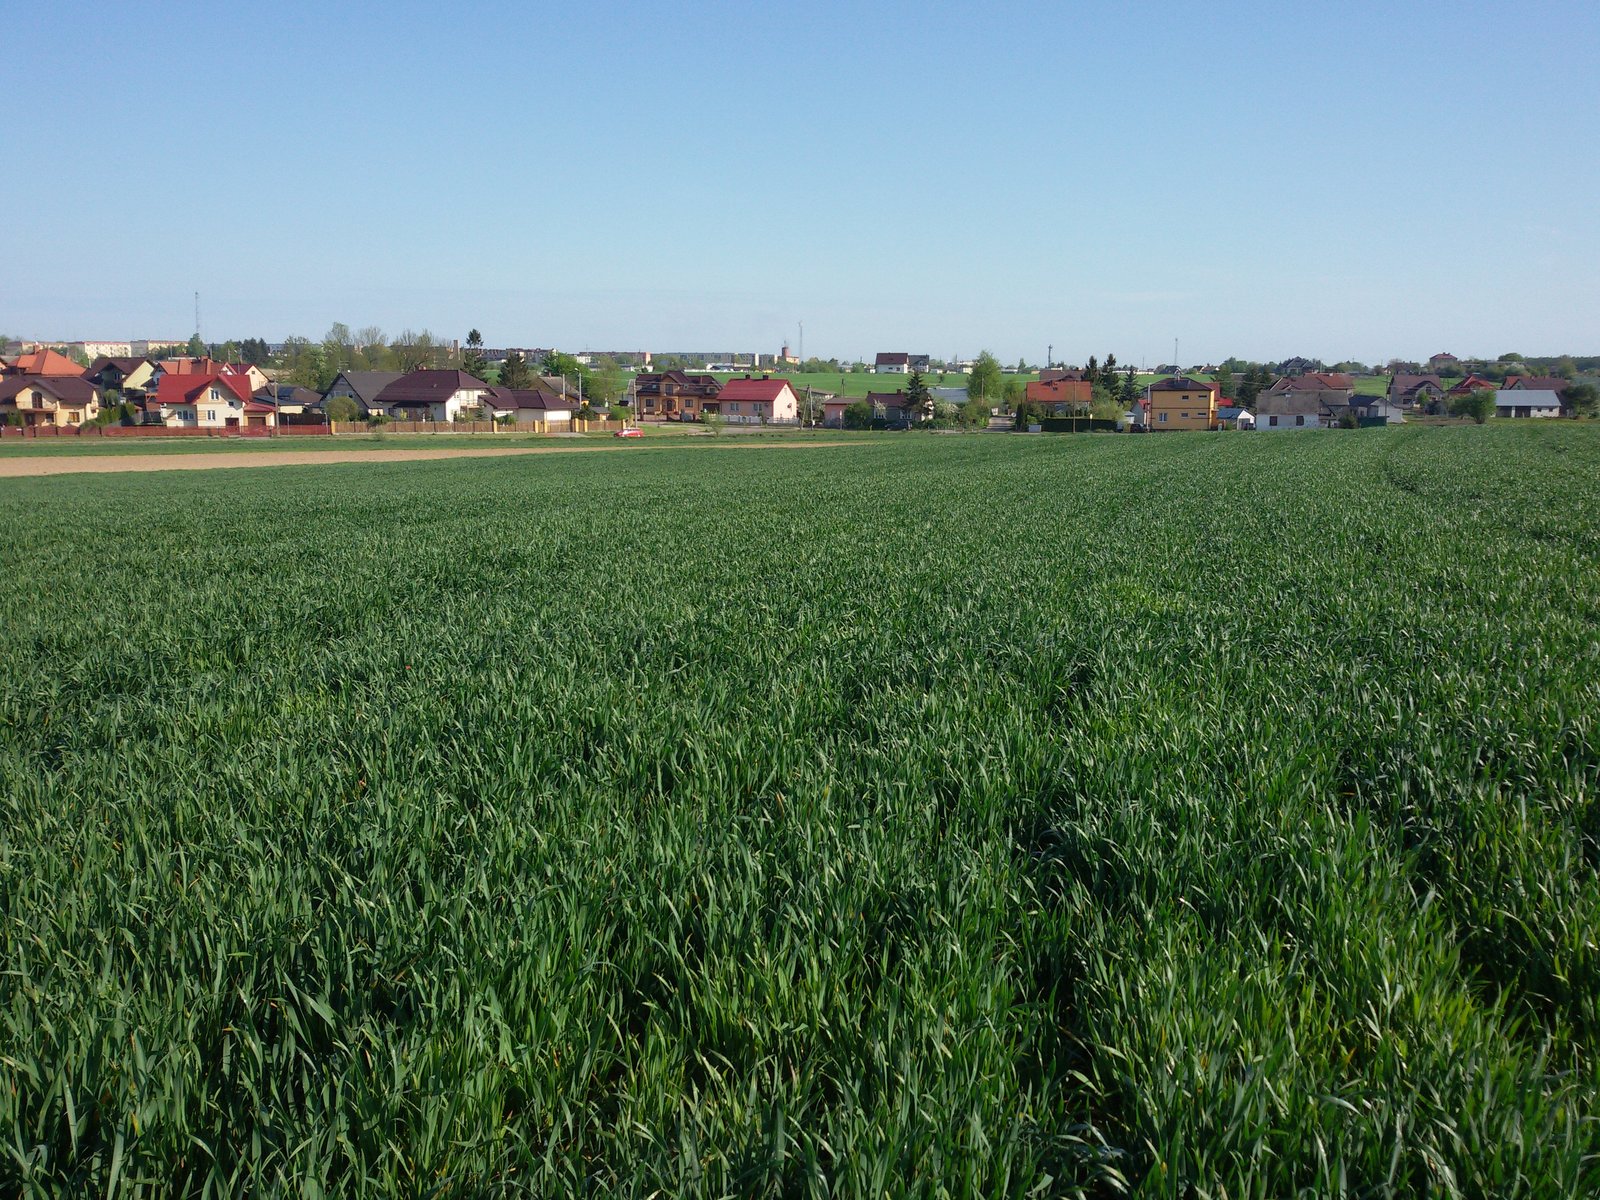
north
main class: Cropland
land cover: Oats
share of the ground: > 75 %
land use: Agriculture (excluding fallow land and kitchen gardens)
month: May
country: PL
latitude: 52.9586
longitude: 22.2539
